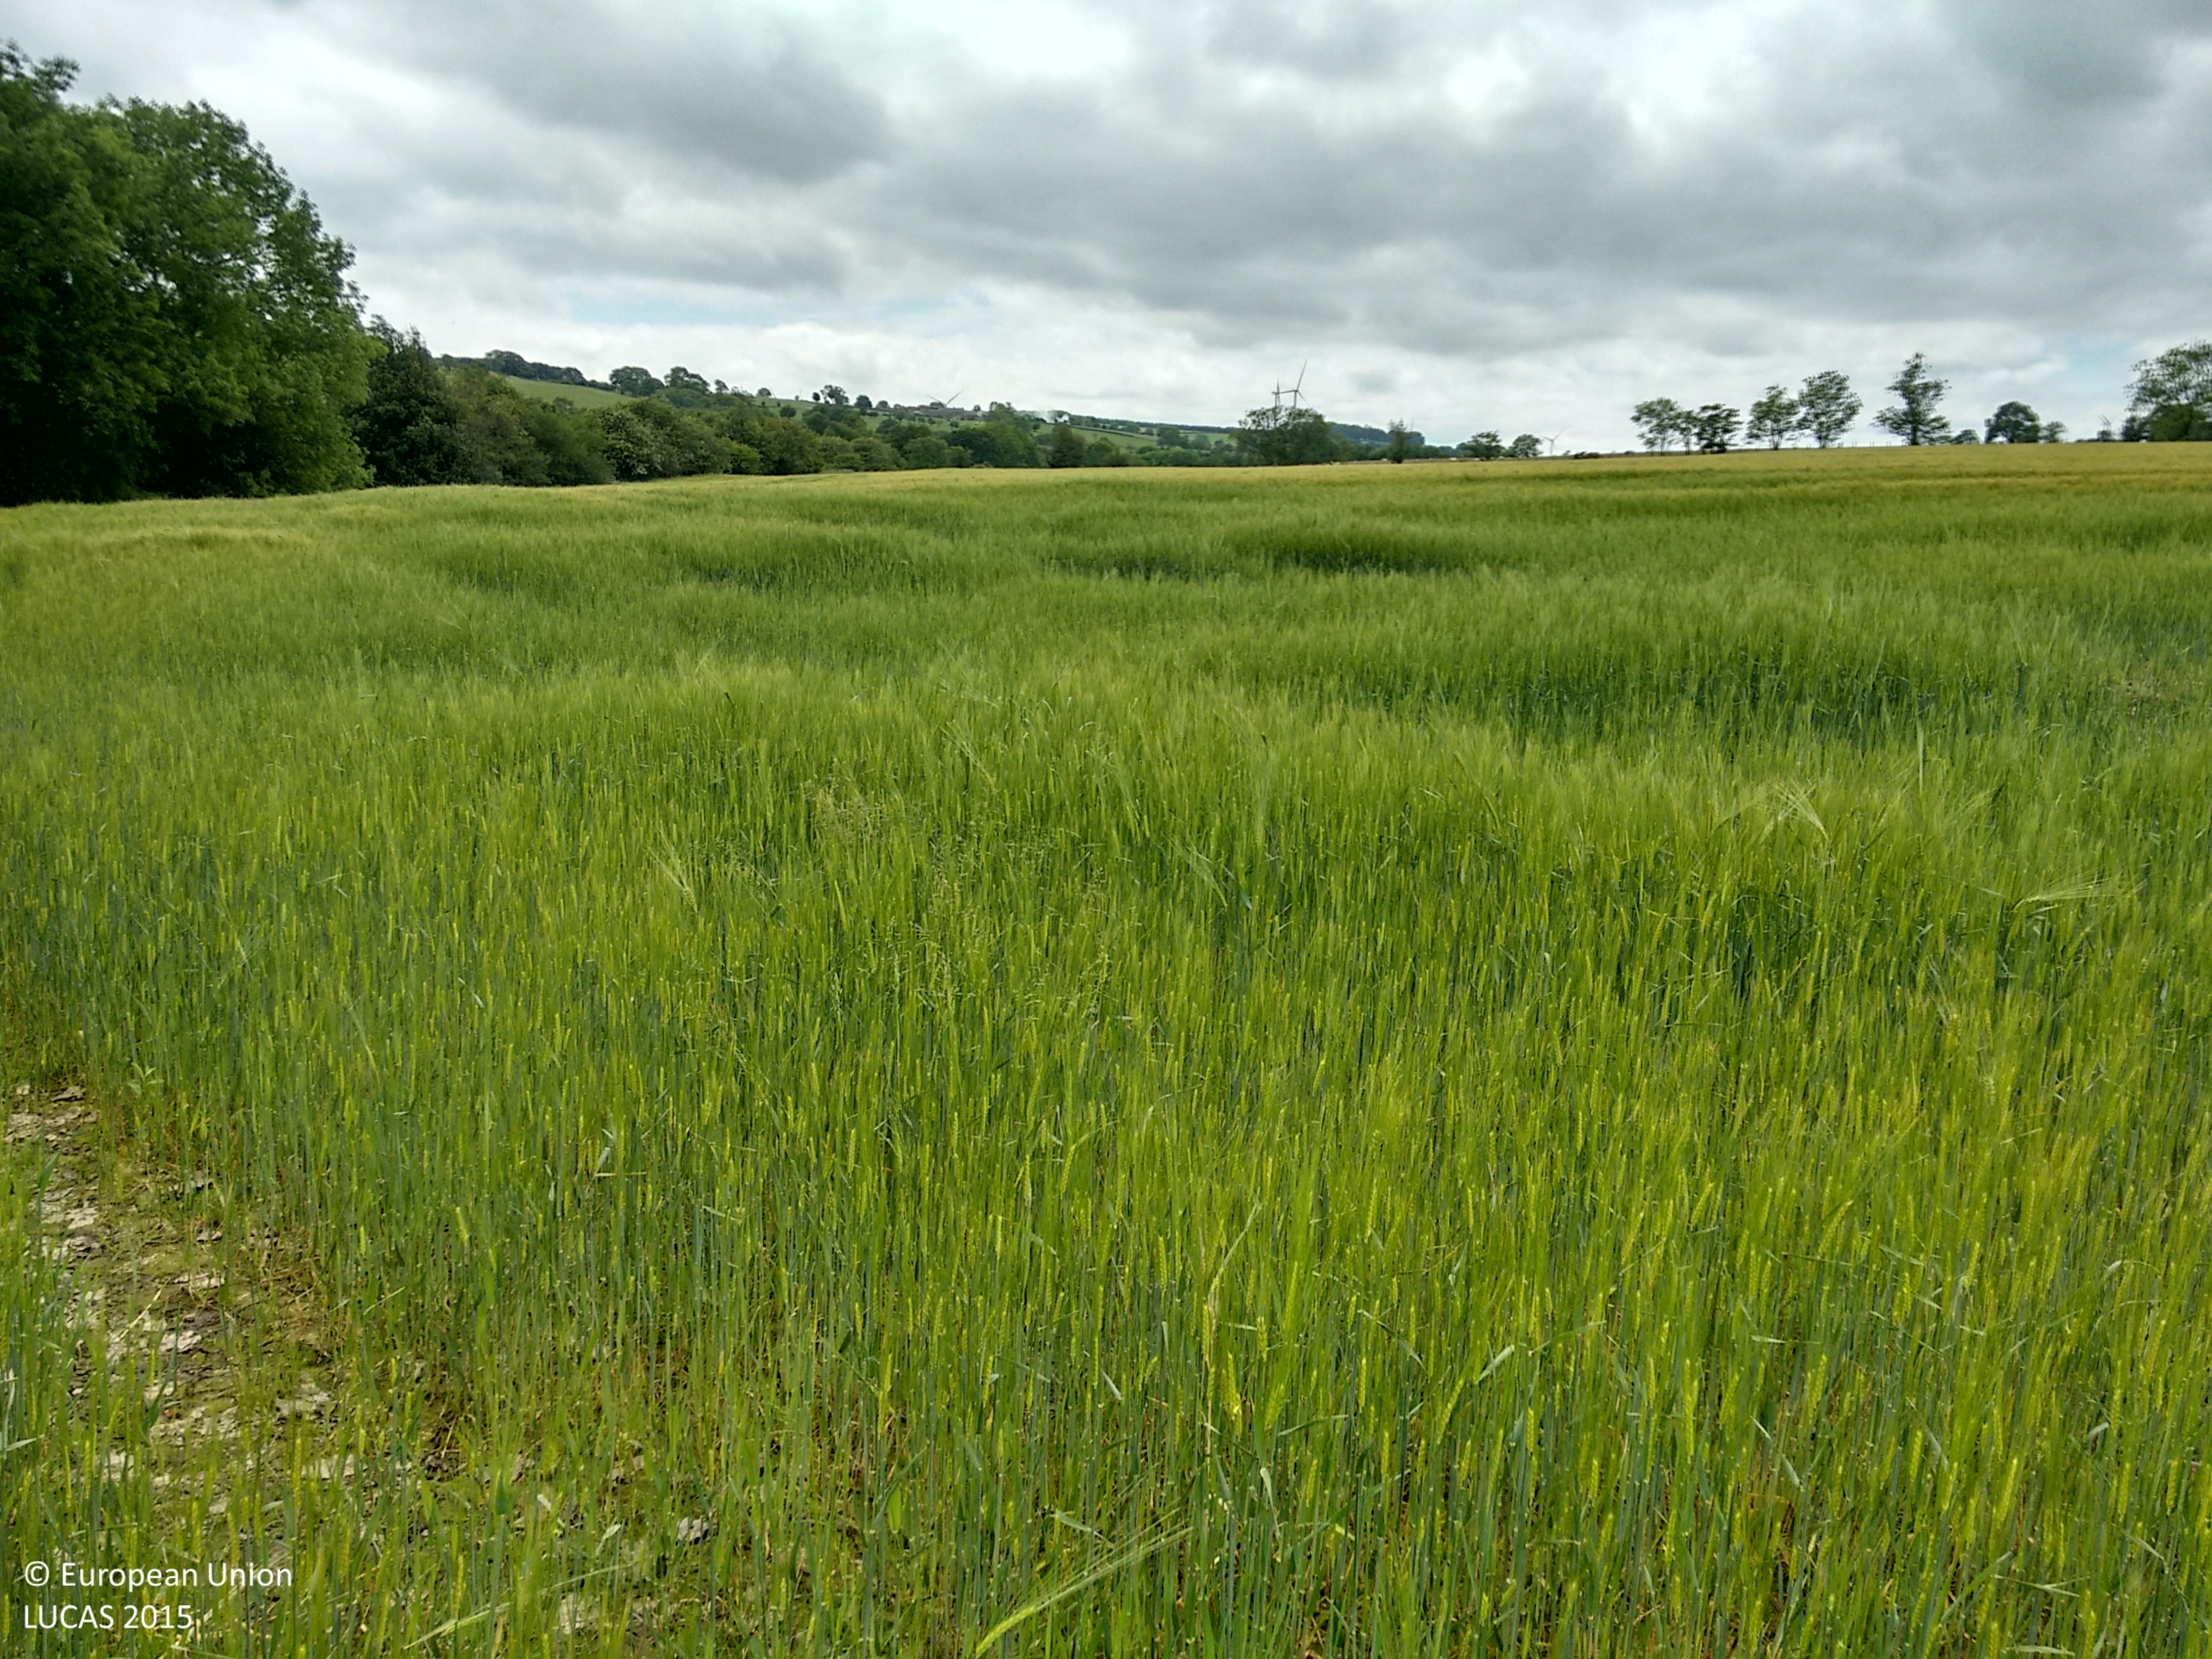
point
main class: Grassland
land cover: Grassland without tree/shrub cover
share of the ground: > 75 %
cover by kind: herbaceous plants 100 %
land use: Agriculture (excluding fallow land and kitchen gardens)
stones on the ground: < 10 %
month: June
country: GB
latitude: 54.7869
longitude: -1.7927
